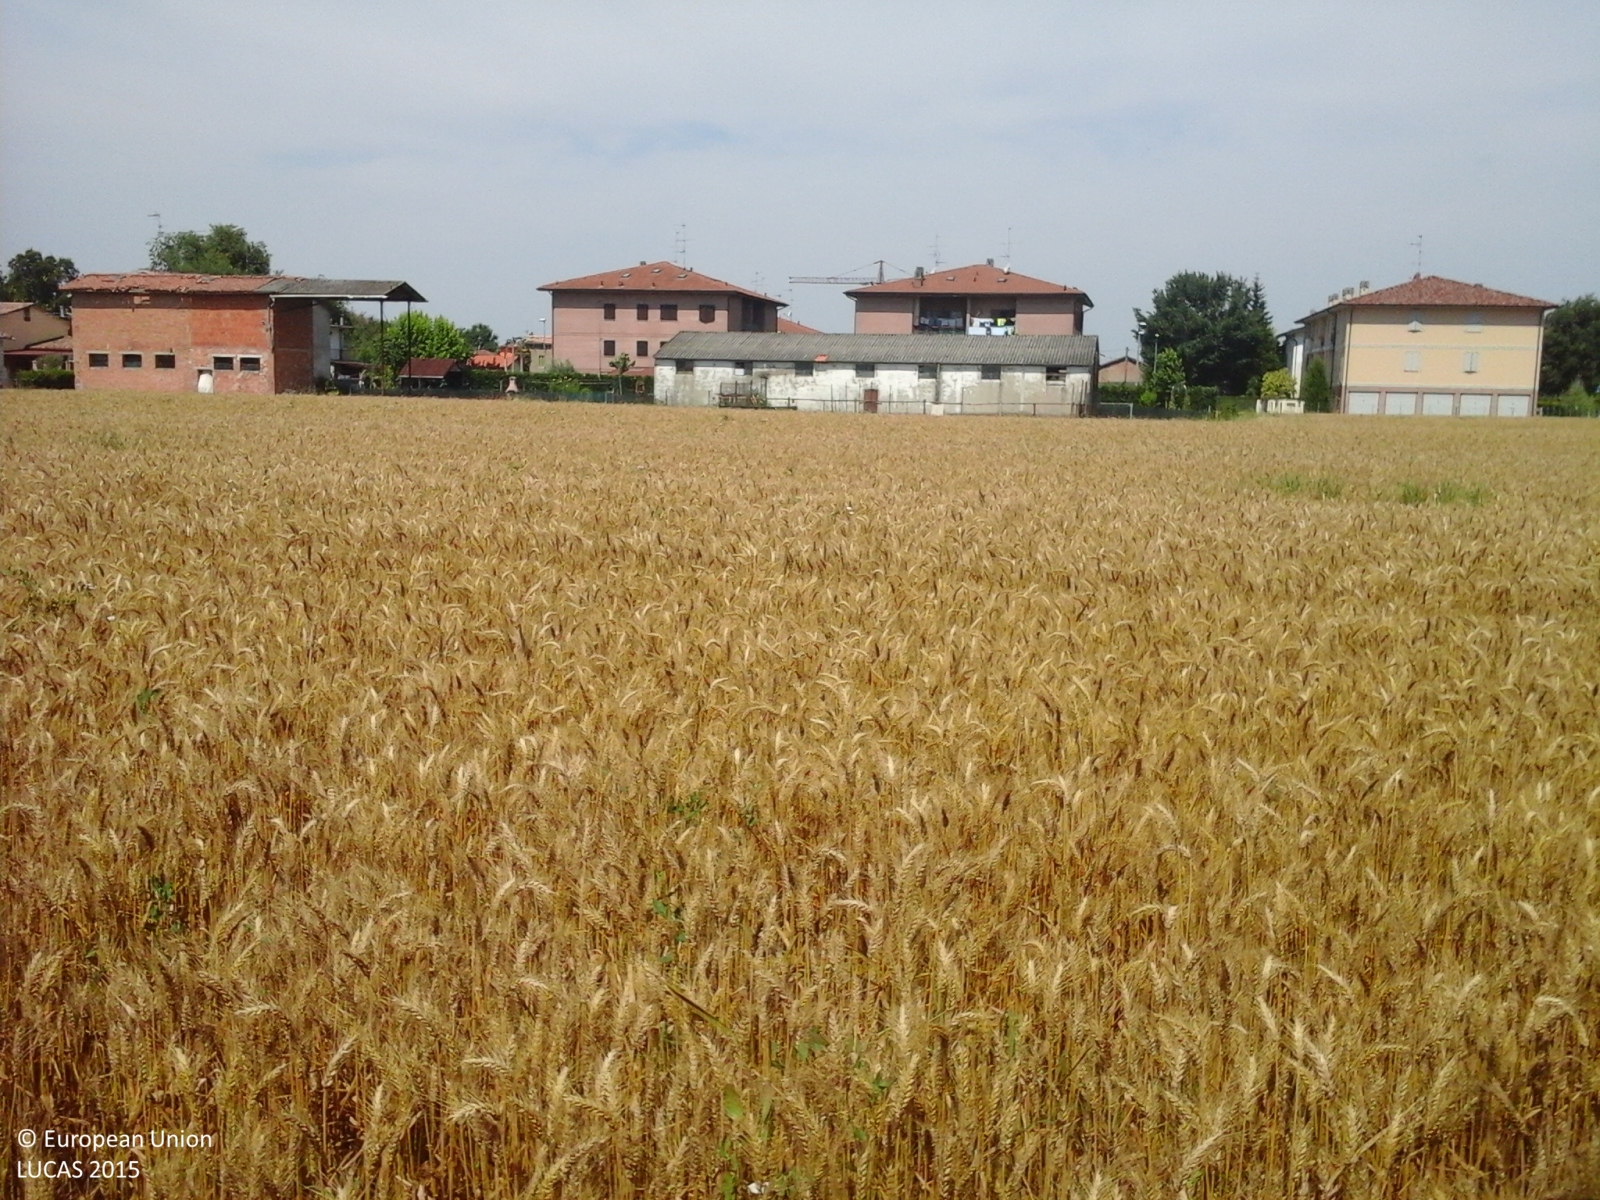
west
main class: Cropland
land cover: Common wheat
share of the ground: > 75 %
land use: Agriculture (excluding fallow land and kitchen gardens)
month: June
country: IT
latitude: 44.6697
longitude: 11.0699
